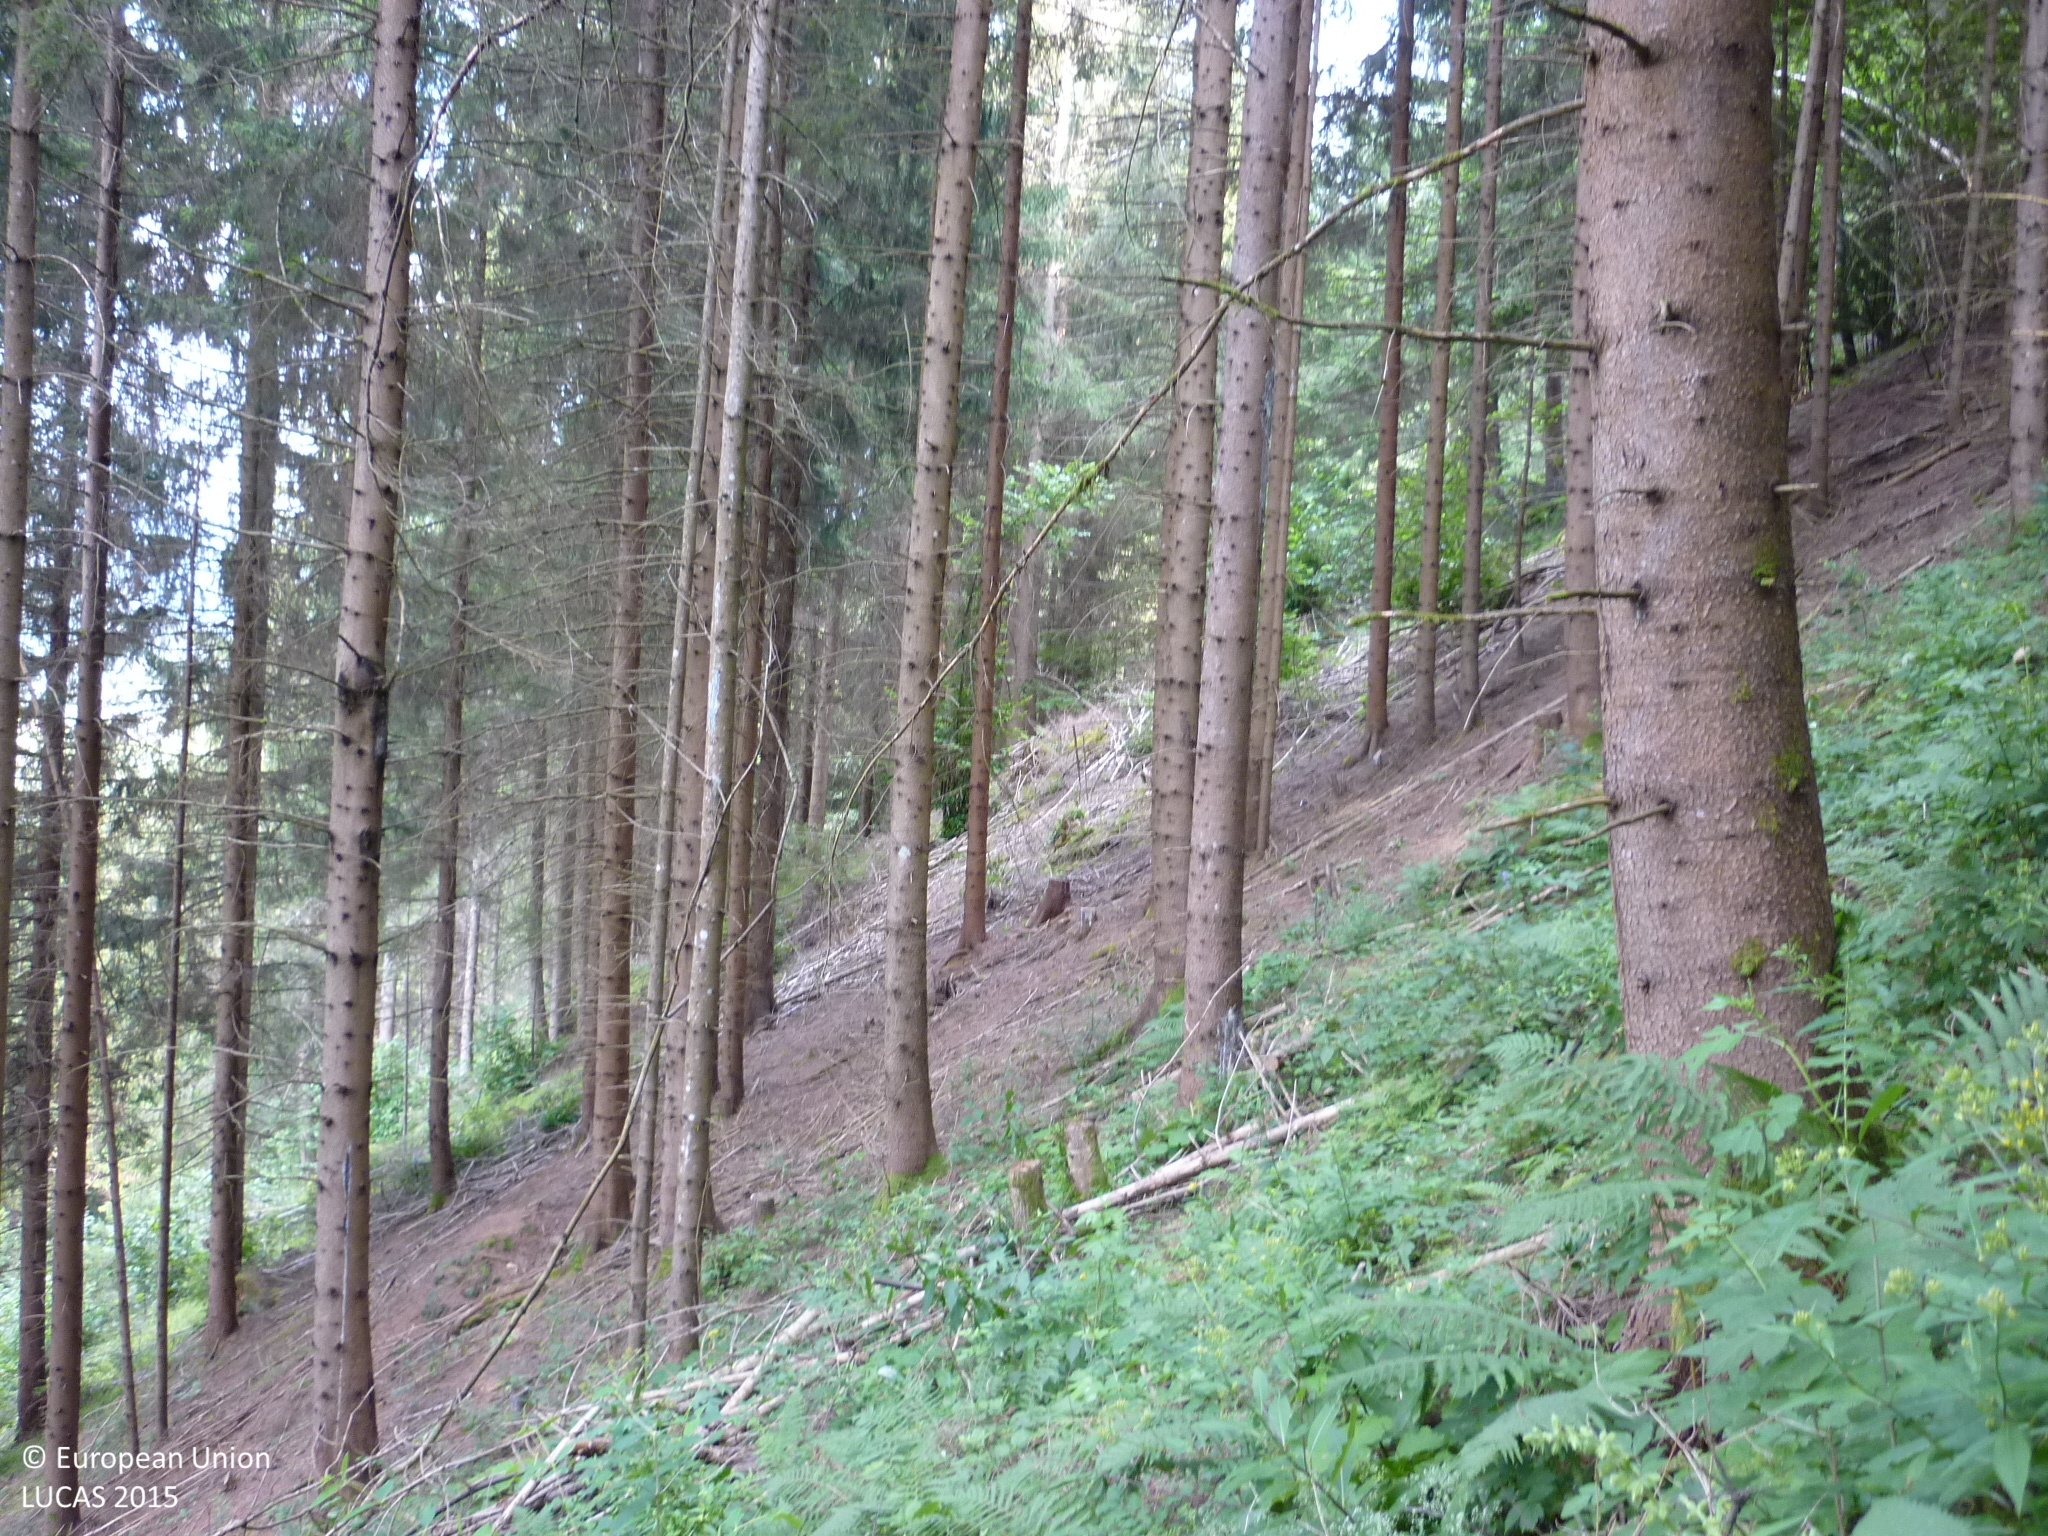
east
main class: Woodland
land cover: Spruce dominated coniferous woodland
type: alpine coniferous forest
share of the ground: > 75 %
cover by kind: coniferous forest trees 95 %, herbaceous plants 5 %
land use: Forestry
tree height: > 5 m
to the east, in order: Spruce dominated coniferous woodland; Spruce dominated mixed woodland; Broadleaved woodland; Spruce dominated mixed woodland; Tracks; Spruce dominated mixed woodland; Shrubland without tree cover; Broadleaved woodland; Rivers and streams; Spontaneously vegetated surfaces; Fences; Spontaneously vegetated surfaces; Broadleaved woodland; Grassland without tree/shrub cover
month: July
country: AT
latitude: 47.1300
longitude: 14.3092
